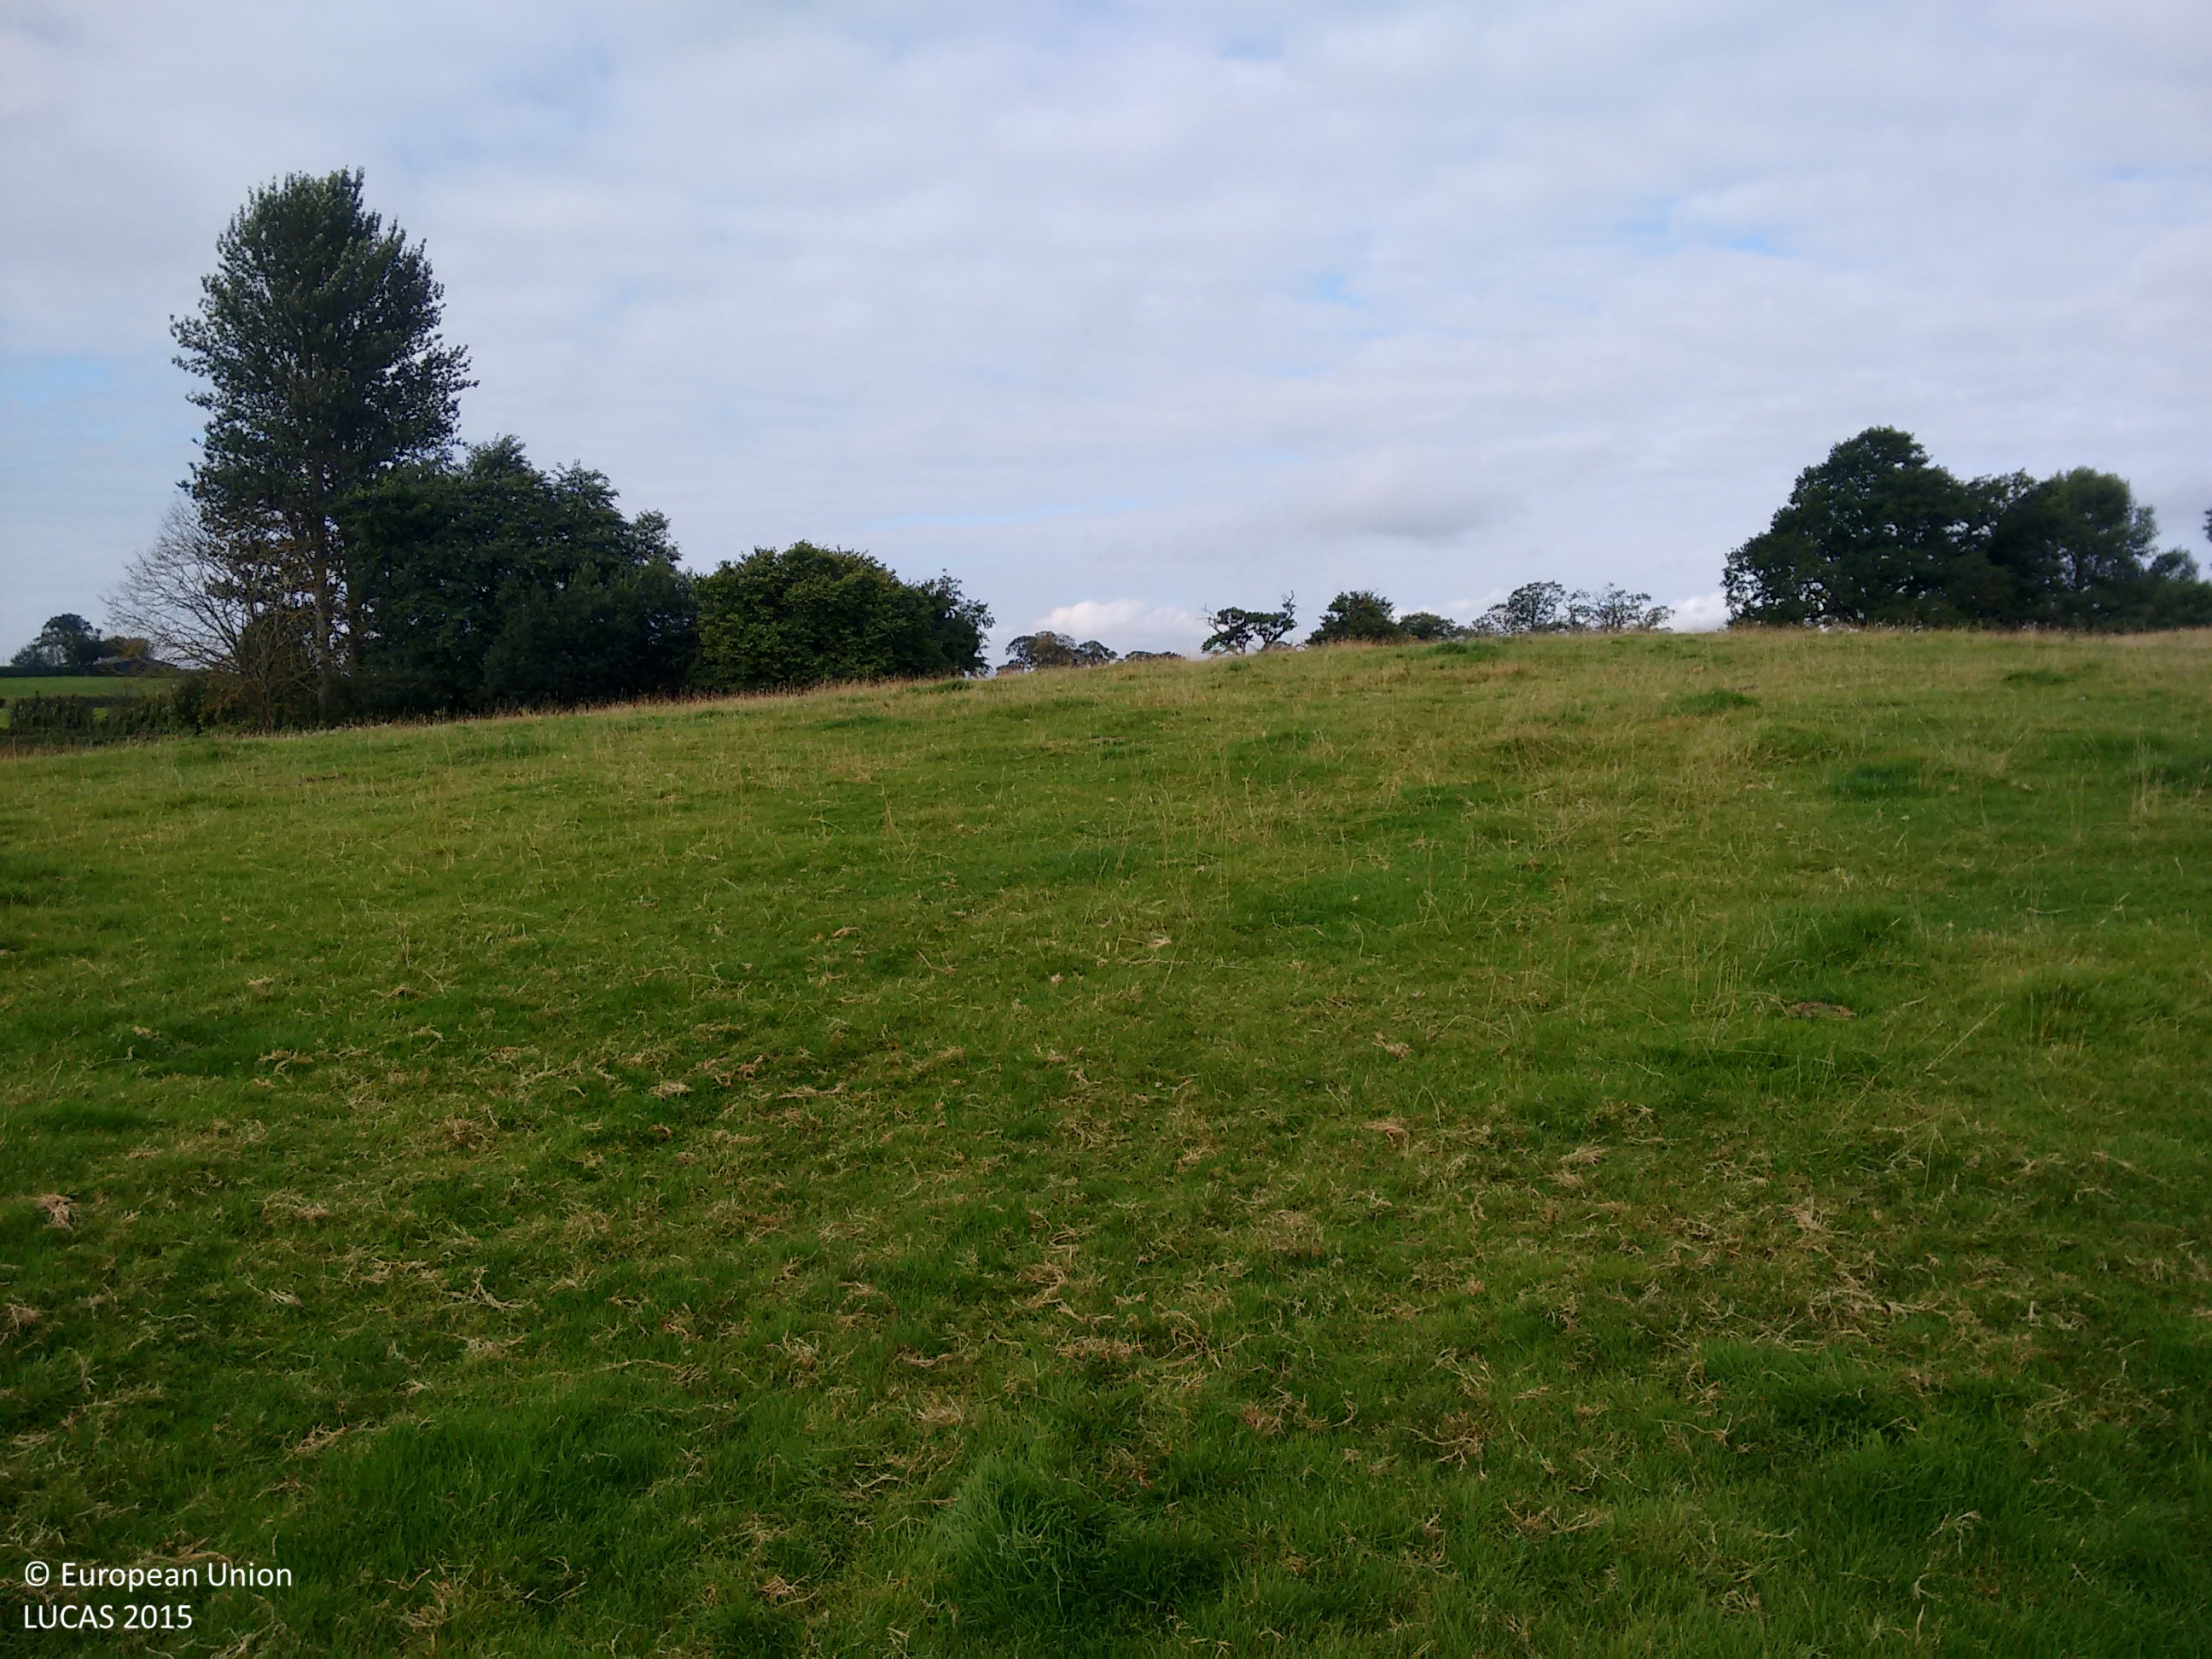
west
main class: Grassland
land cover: Grassland without tree/shrub cover
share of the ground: > 75 %
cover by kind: herbaceous plants 100 %
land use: Agriculture (excluding fallow land and kitchen gardens)
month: September
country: GB
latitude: 52.8728
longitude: -2.8944
